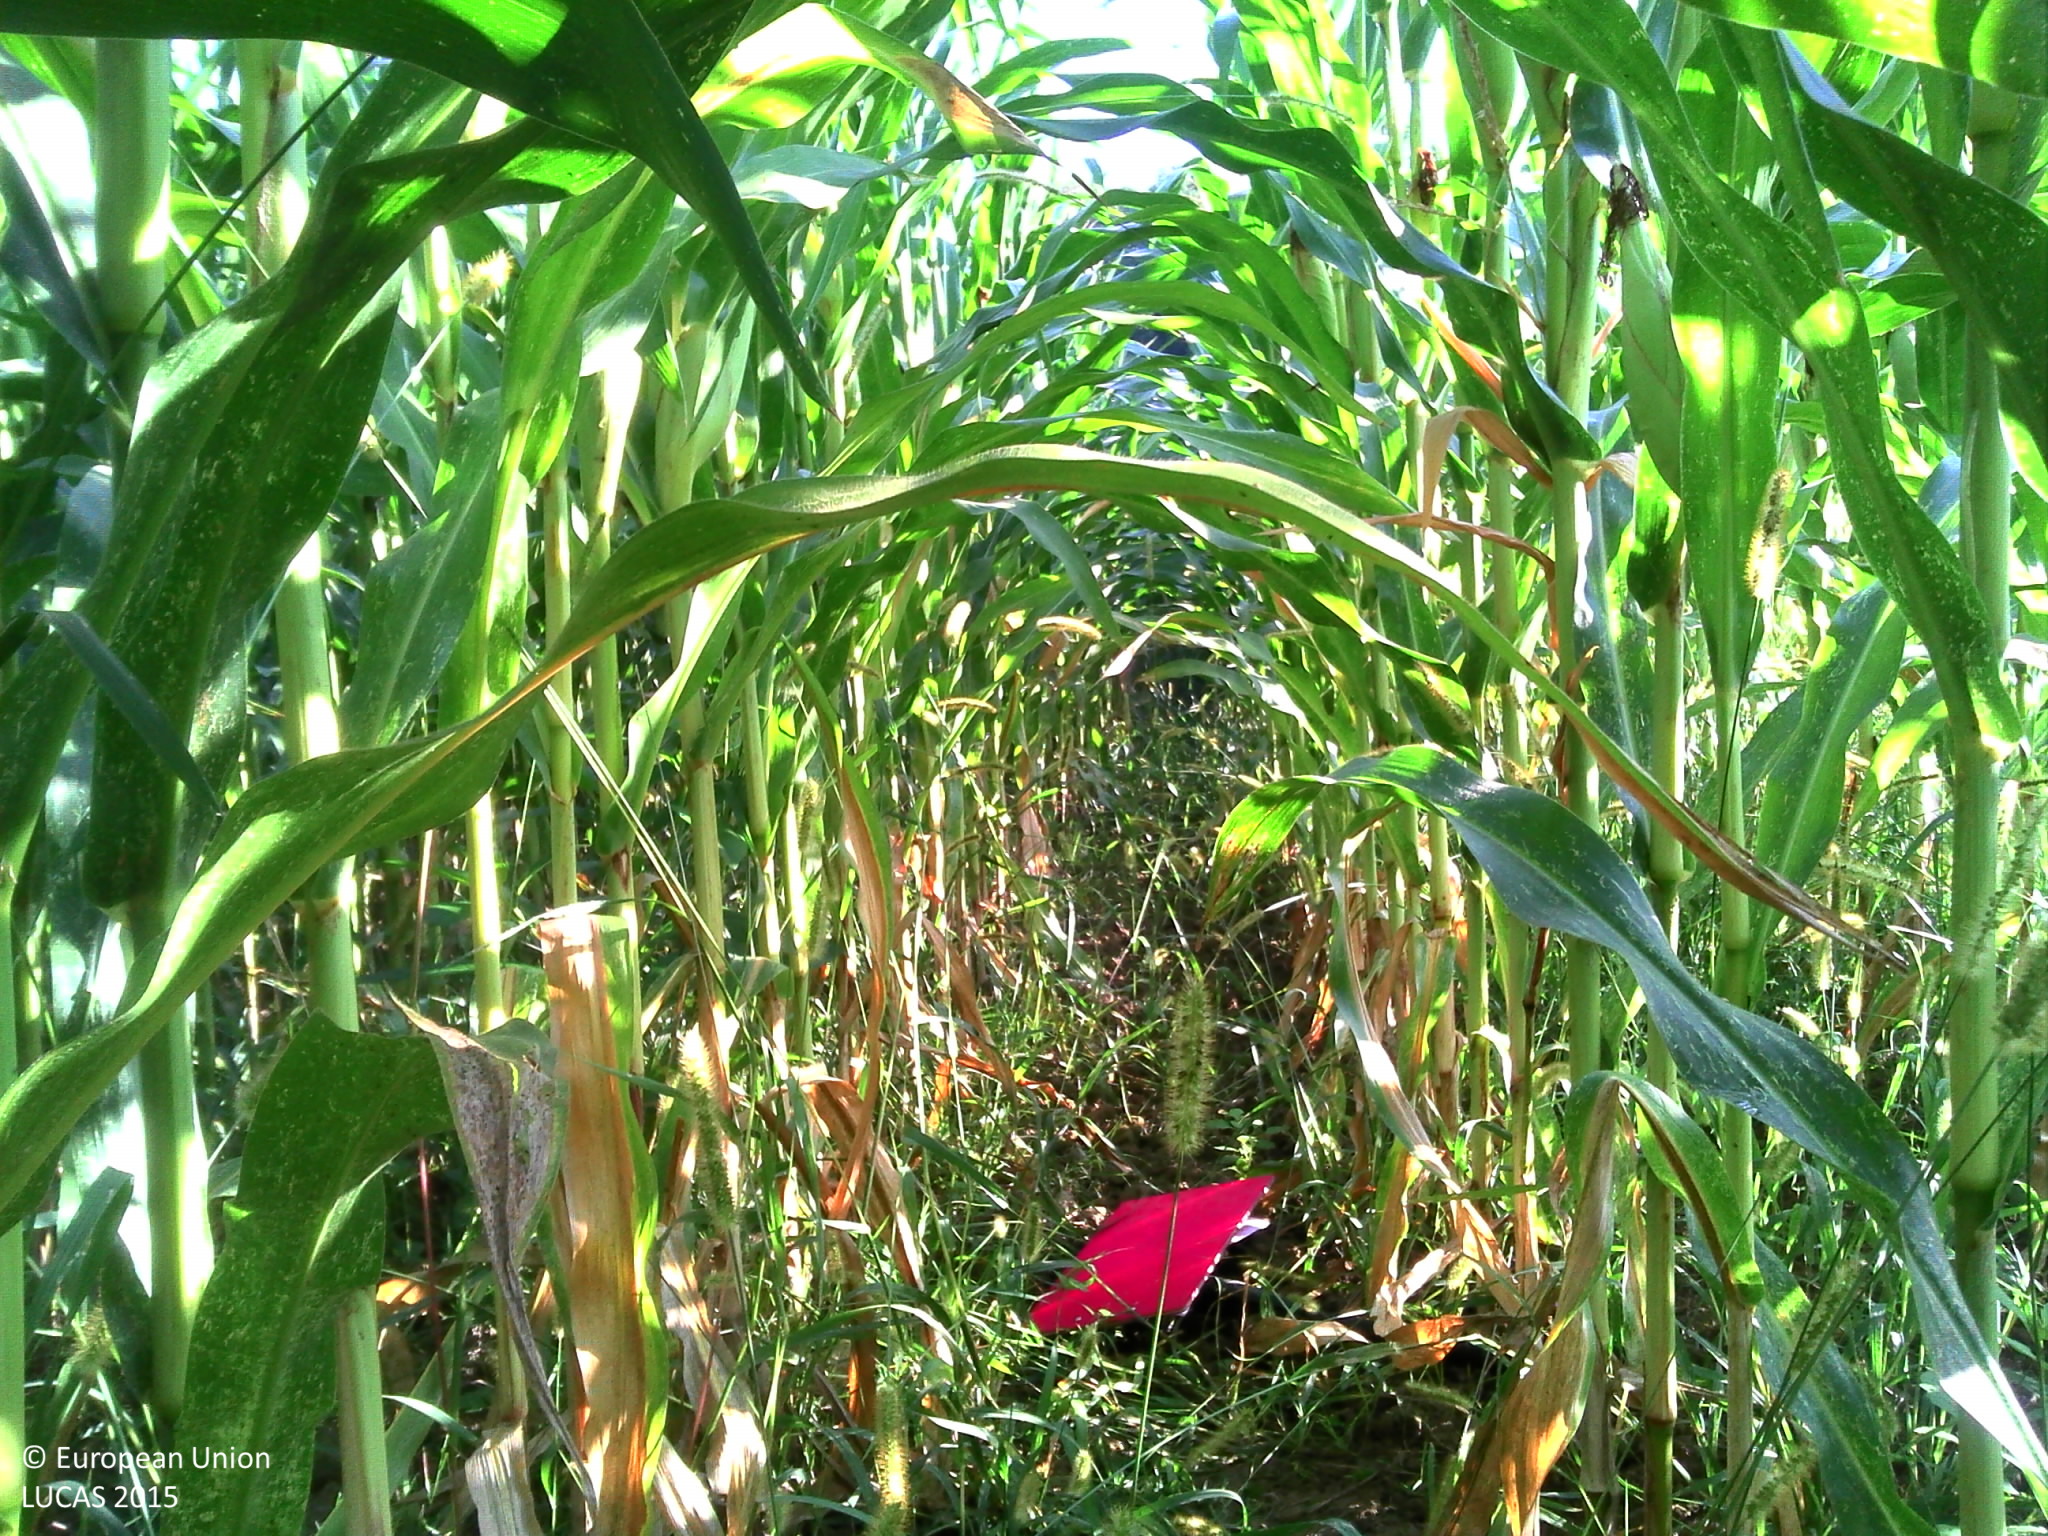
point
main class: Cropland
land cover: Maize
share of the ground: > 75 %
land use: Agriculture (excluding fallow land and kitchen gardens)
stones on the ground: 10 - 25 %
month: September
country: FR
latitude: 43.5242
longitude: -0.6884
